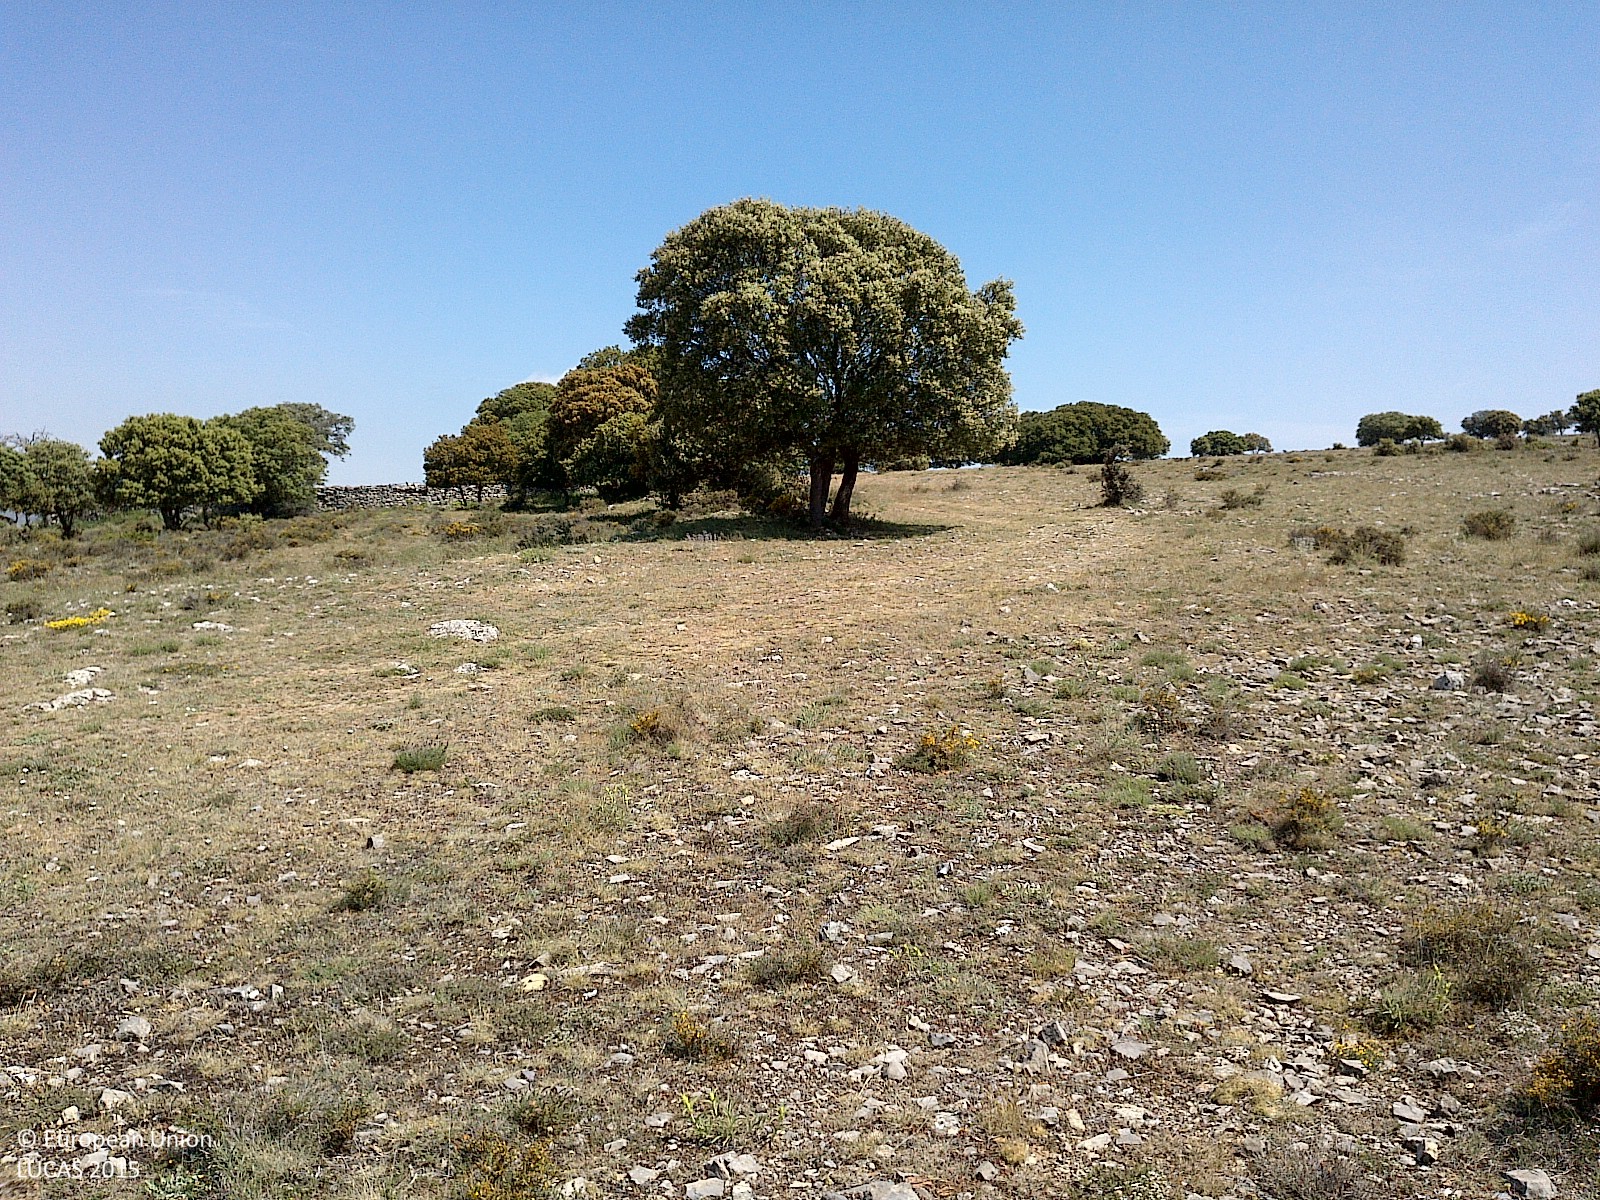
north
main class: Grassland
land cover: Grassland without tree/shrub cover
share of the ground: > 75 %
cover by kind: herbaceous plants 80 %, consolidated bare surface 15 %, shrubs 5 %
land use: Semi-natural and natural areas not in use
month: May
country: ES
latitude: 41.8631
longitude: -2.3131
